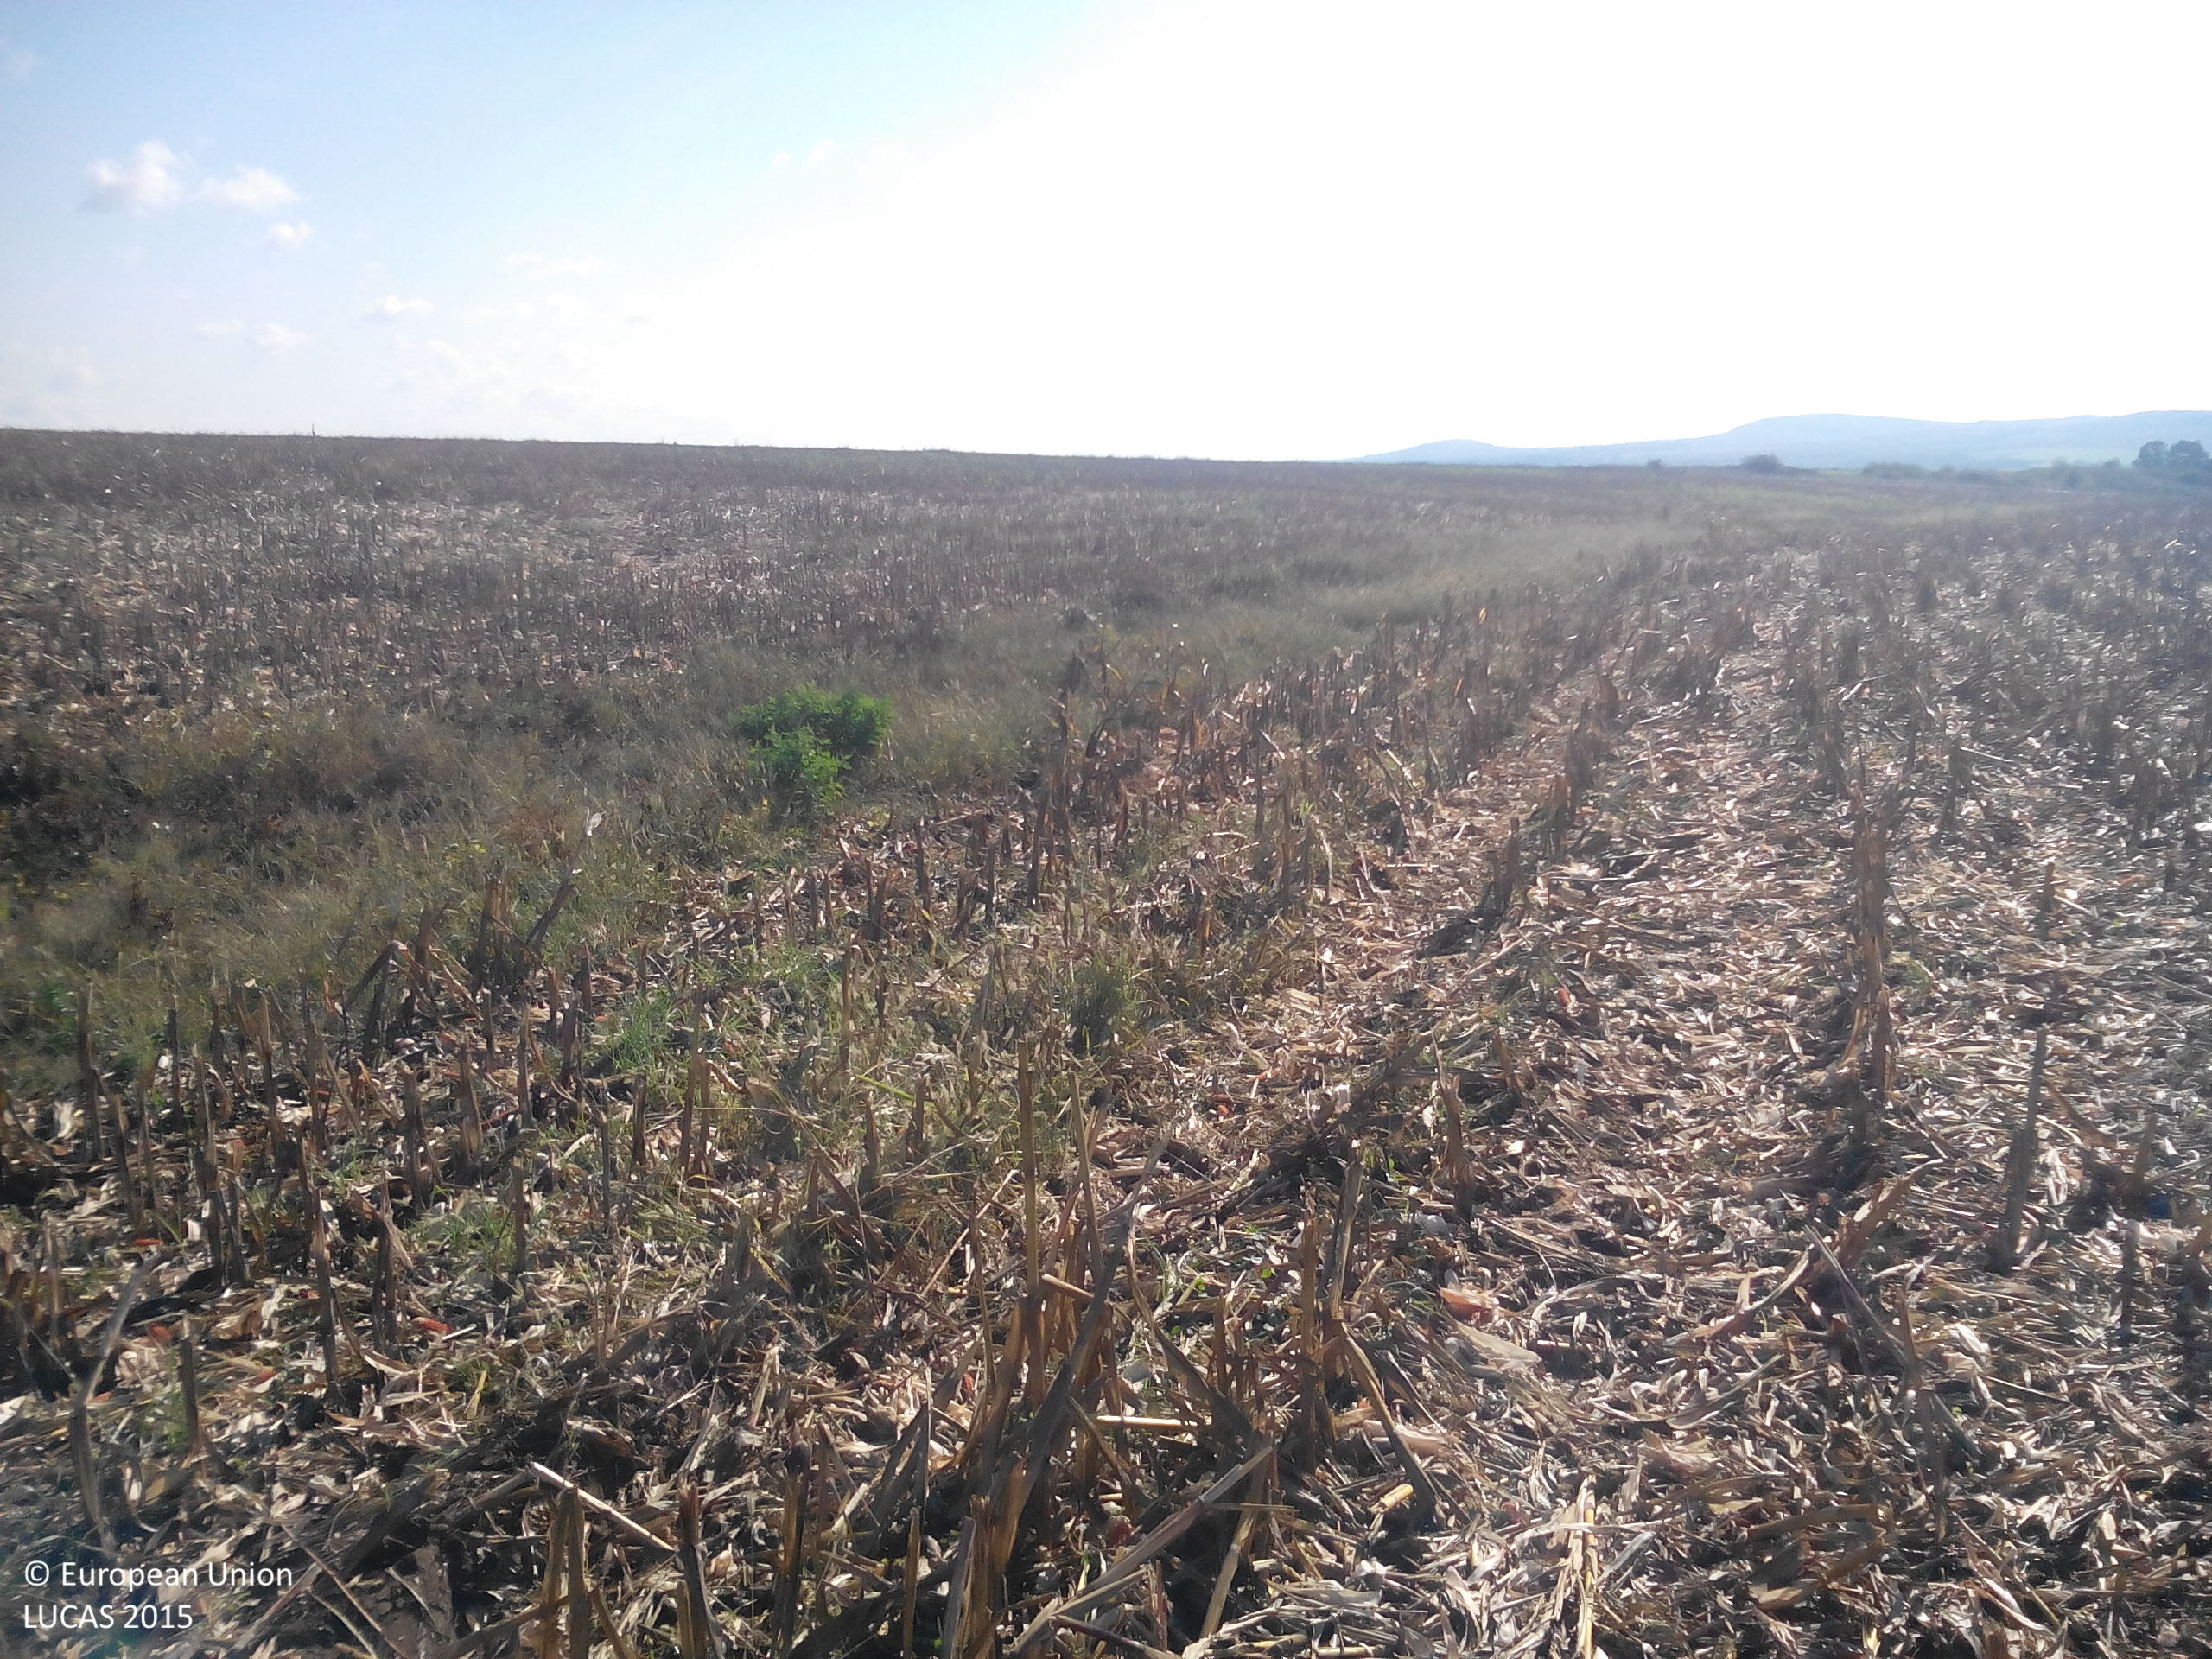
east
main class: Cropland
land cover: Maize
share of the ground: 10 - 25 %
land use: Agriculture (excluding fallow land and kitchen gardens)
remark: Harvested field
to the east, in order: Maize; Grass margins; Maize; Grass margins; Tracks; Common wheat
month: October
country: BG
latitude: 43.3918
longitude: 23.7636
